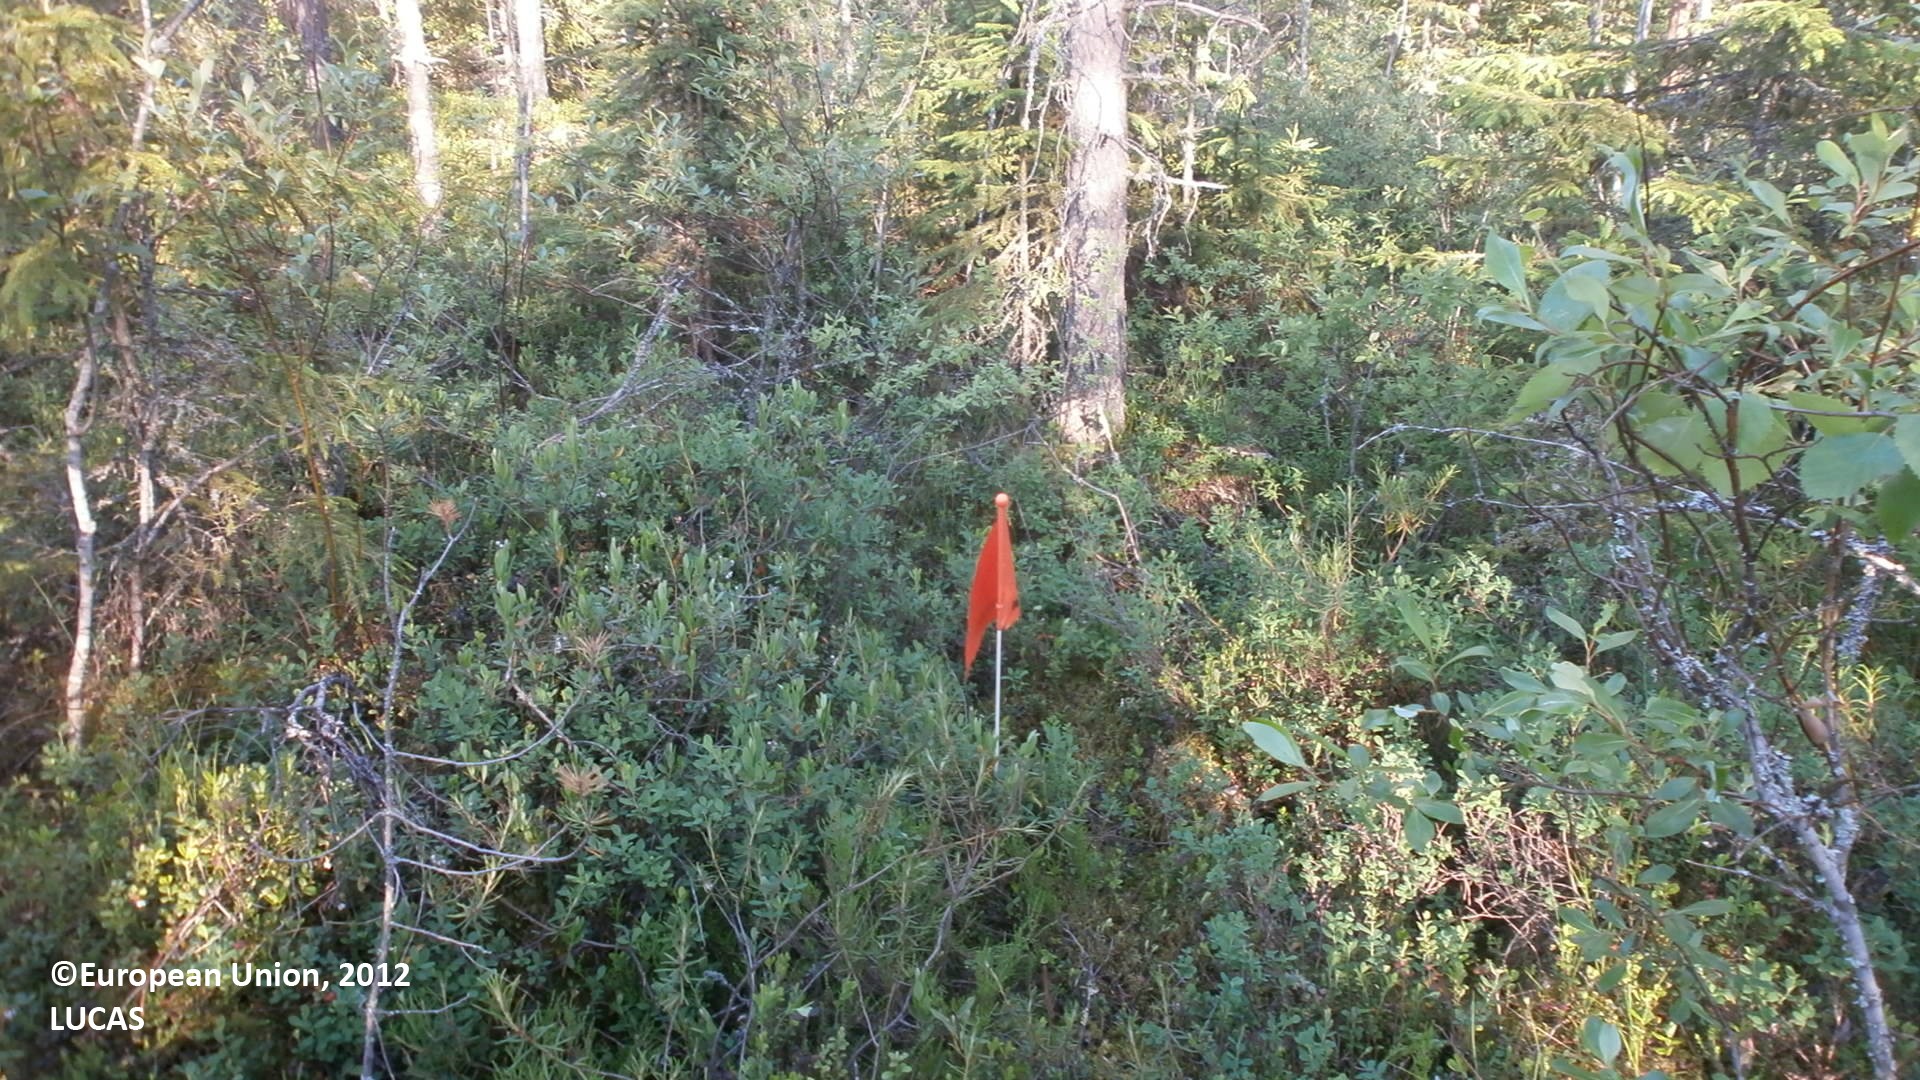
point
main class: Woodland
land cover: Pine dominated coniferous woodland
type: boreal forest
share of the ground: 50 - 75 %
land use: Forestry
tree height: > 5 m
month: July
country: FI
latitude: 64.2380
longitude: 24.9490
